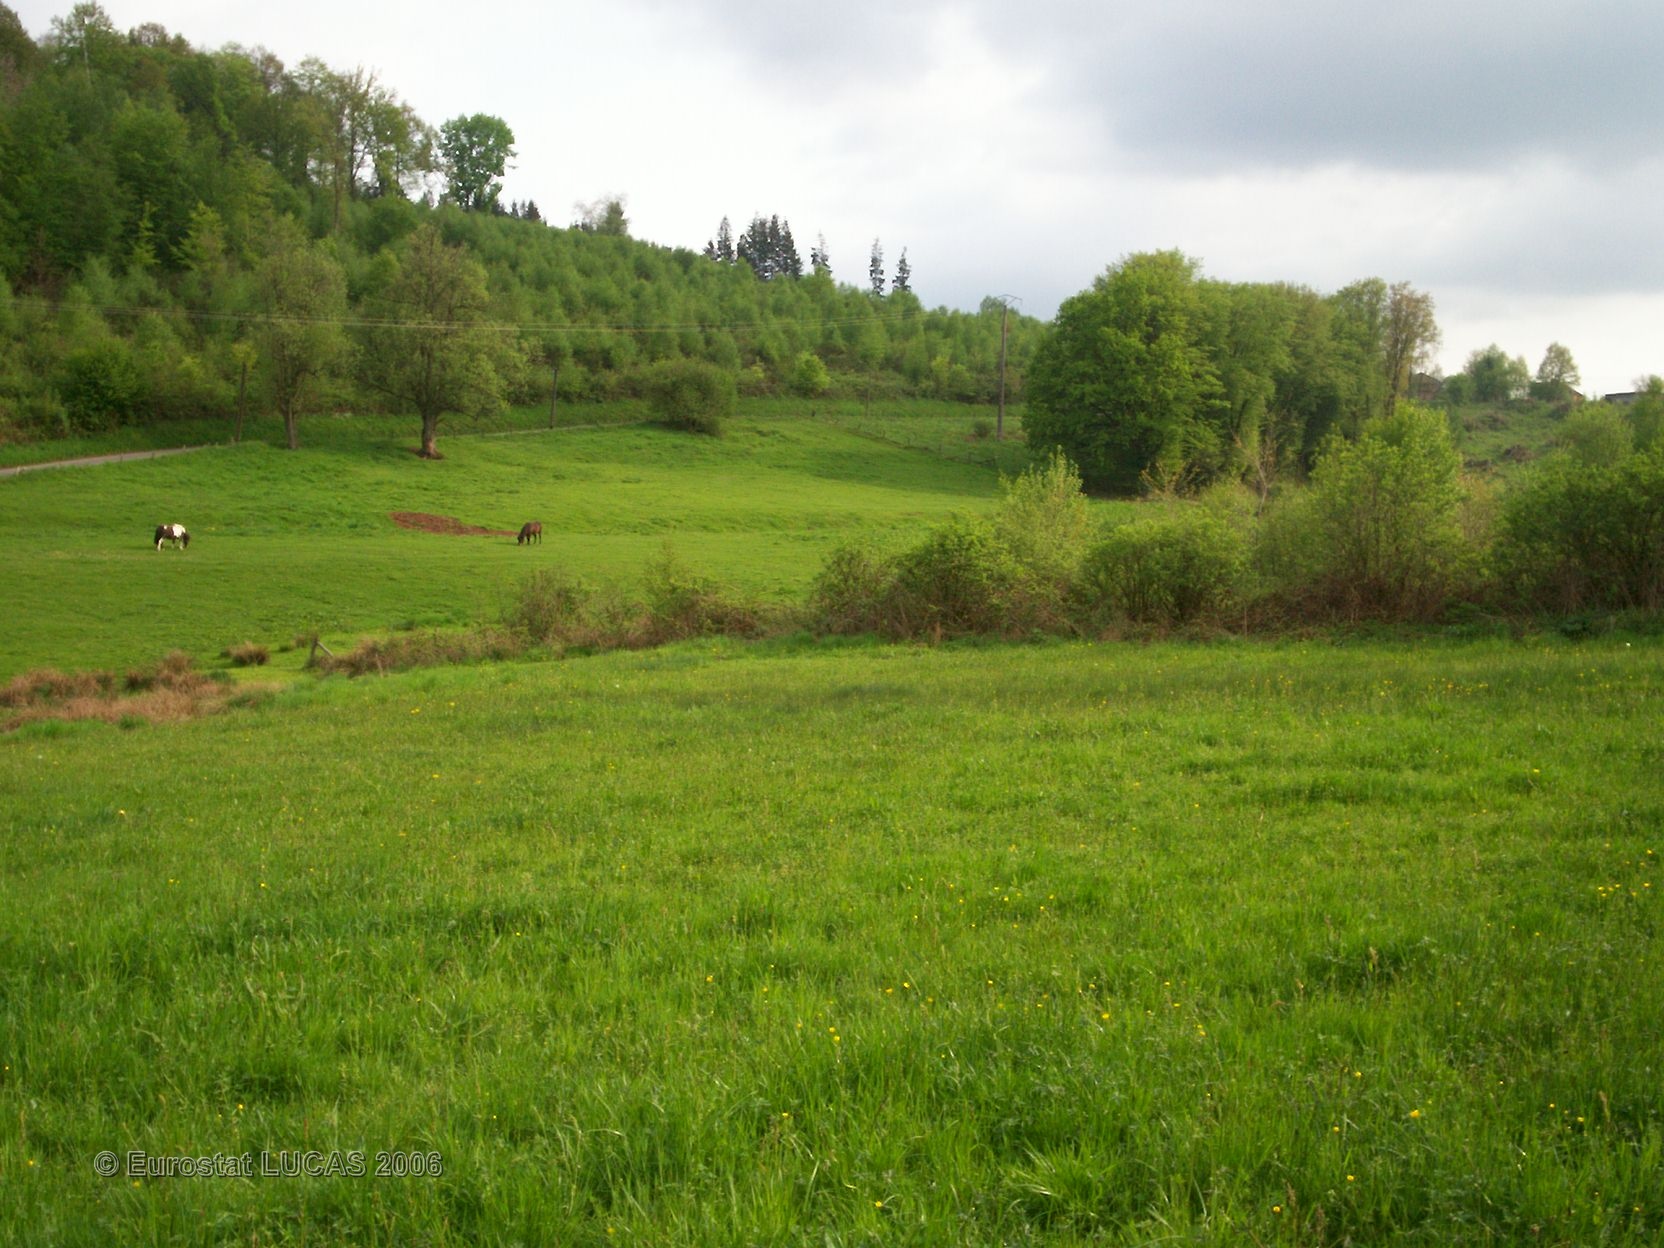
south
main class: Grassland
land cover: Grassland without tree/shrub cover
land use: Agriculture (excluding fallow land and kitchen gardens)
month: May
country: FR
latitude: 48.5970
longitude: 7.0040
